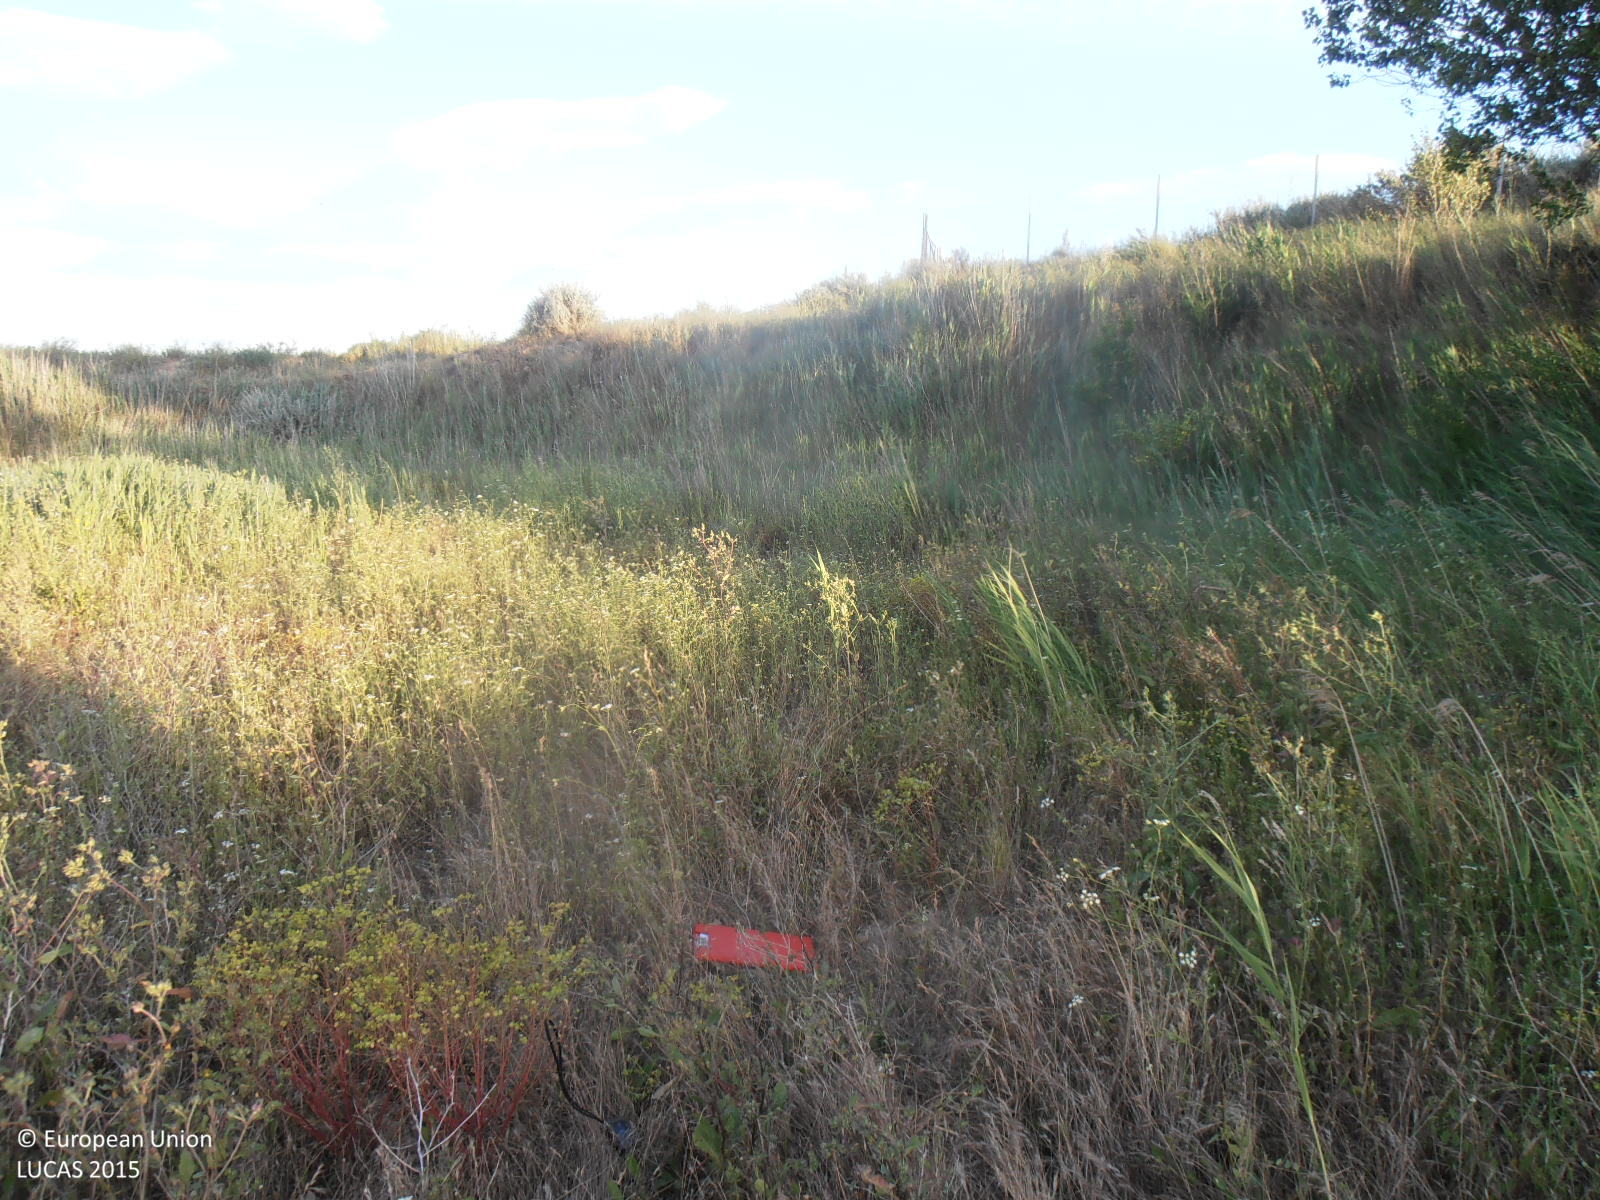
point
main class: Grassland
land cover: Grassland without tree/shrub cover
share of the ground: > 75 %
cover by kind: herbaceous plants 100 %
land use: Abandoned areas
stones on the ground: < 10 %
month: June
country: ES
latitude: 41.9460
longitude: -1.3065
